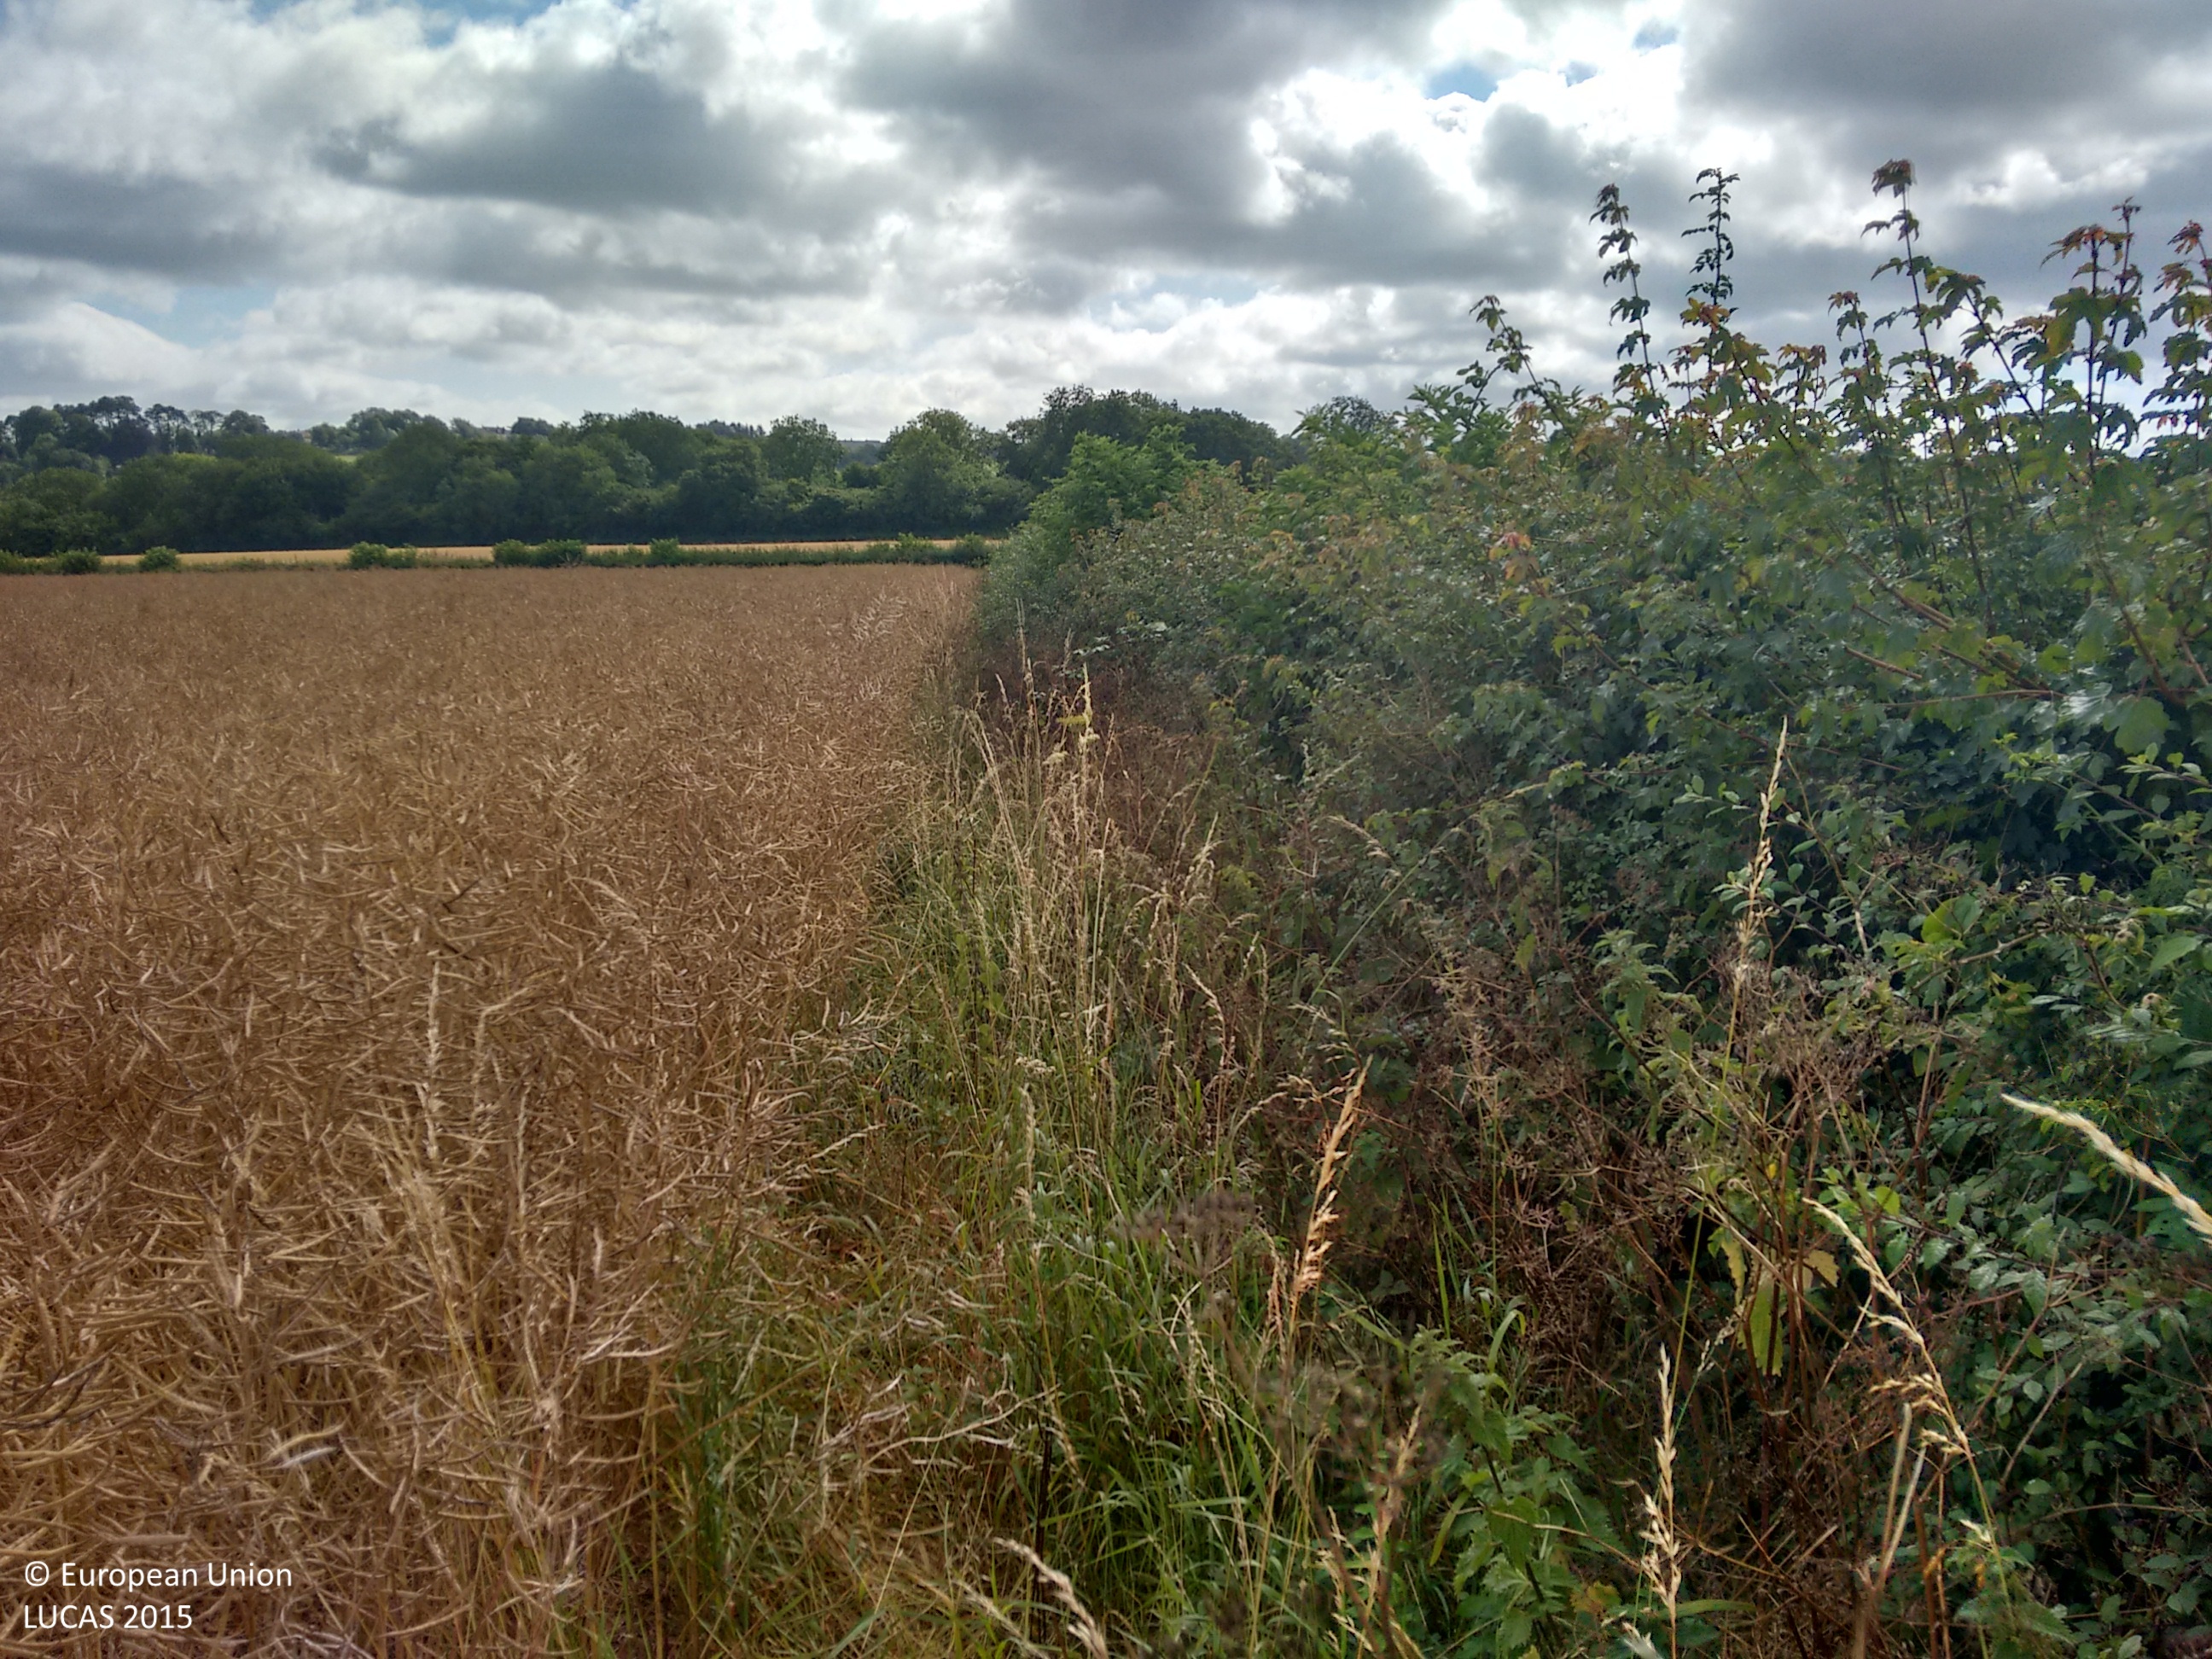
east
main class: Cropland
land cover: Rape and turnip rape
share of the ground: > 75 %
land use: Agriculture (excluding fallow land and kitchen gardens)
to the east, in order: Rape and turnip rape; Managed hedges; Fences; Shruby margins; Common wheat; Grass margins; Fences; Broadleaved woodland
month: July
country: GB
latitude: 51.3601
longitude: -2.4013
